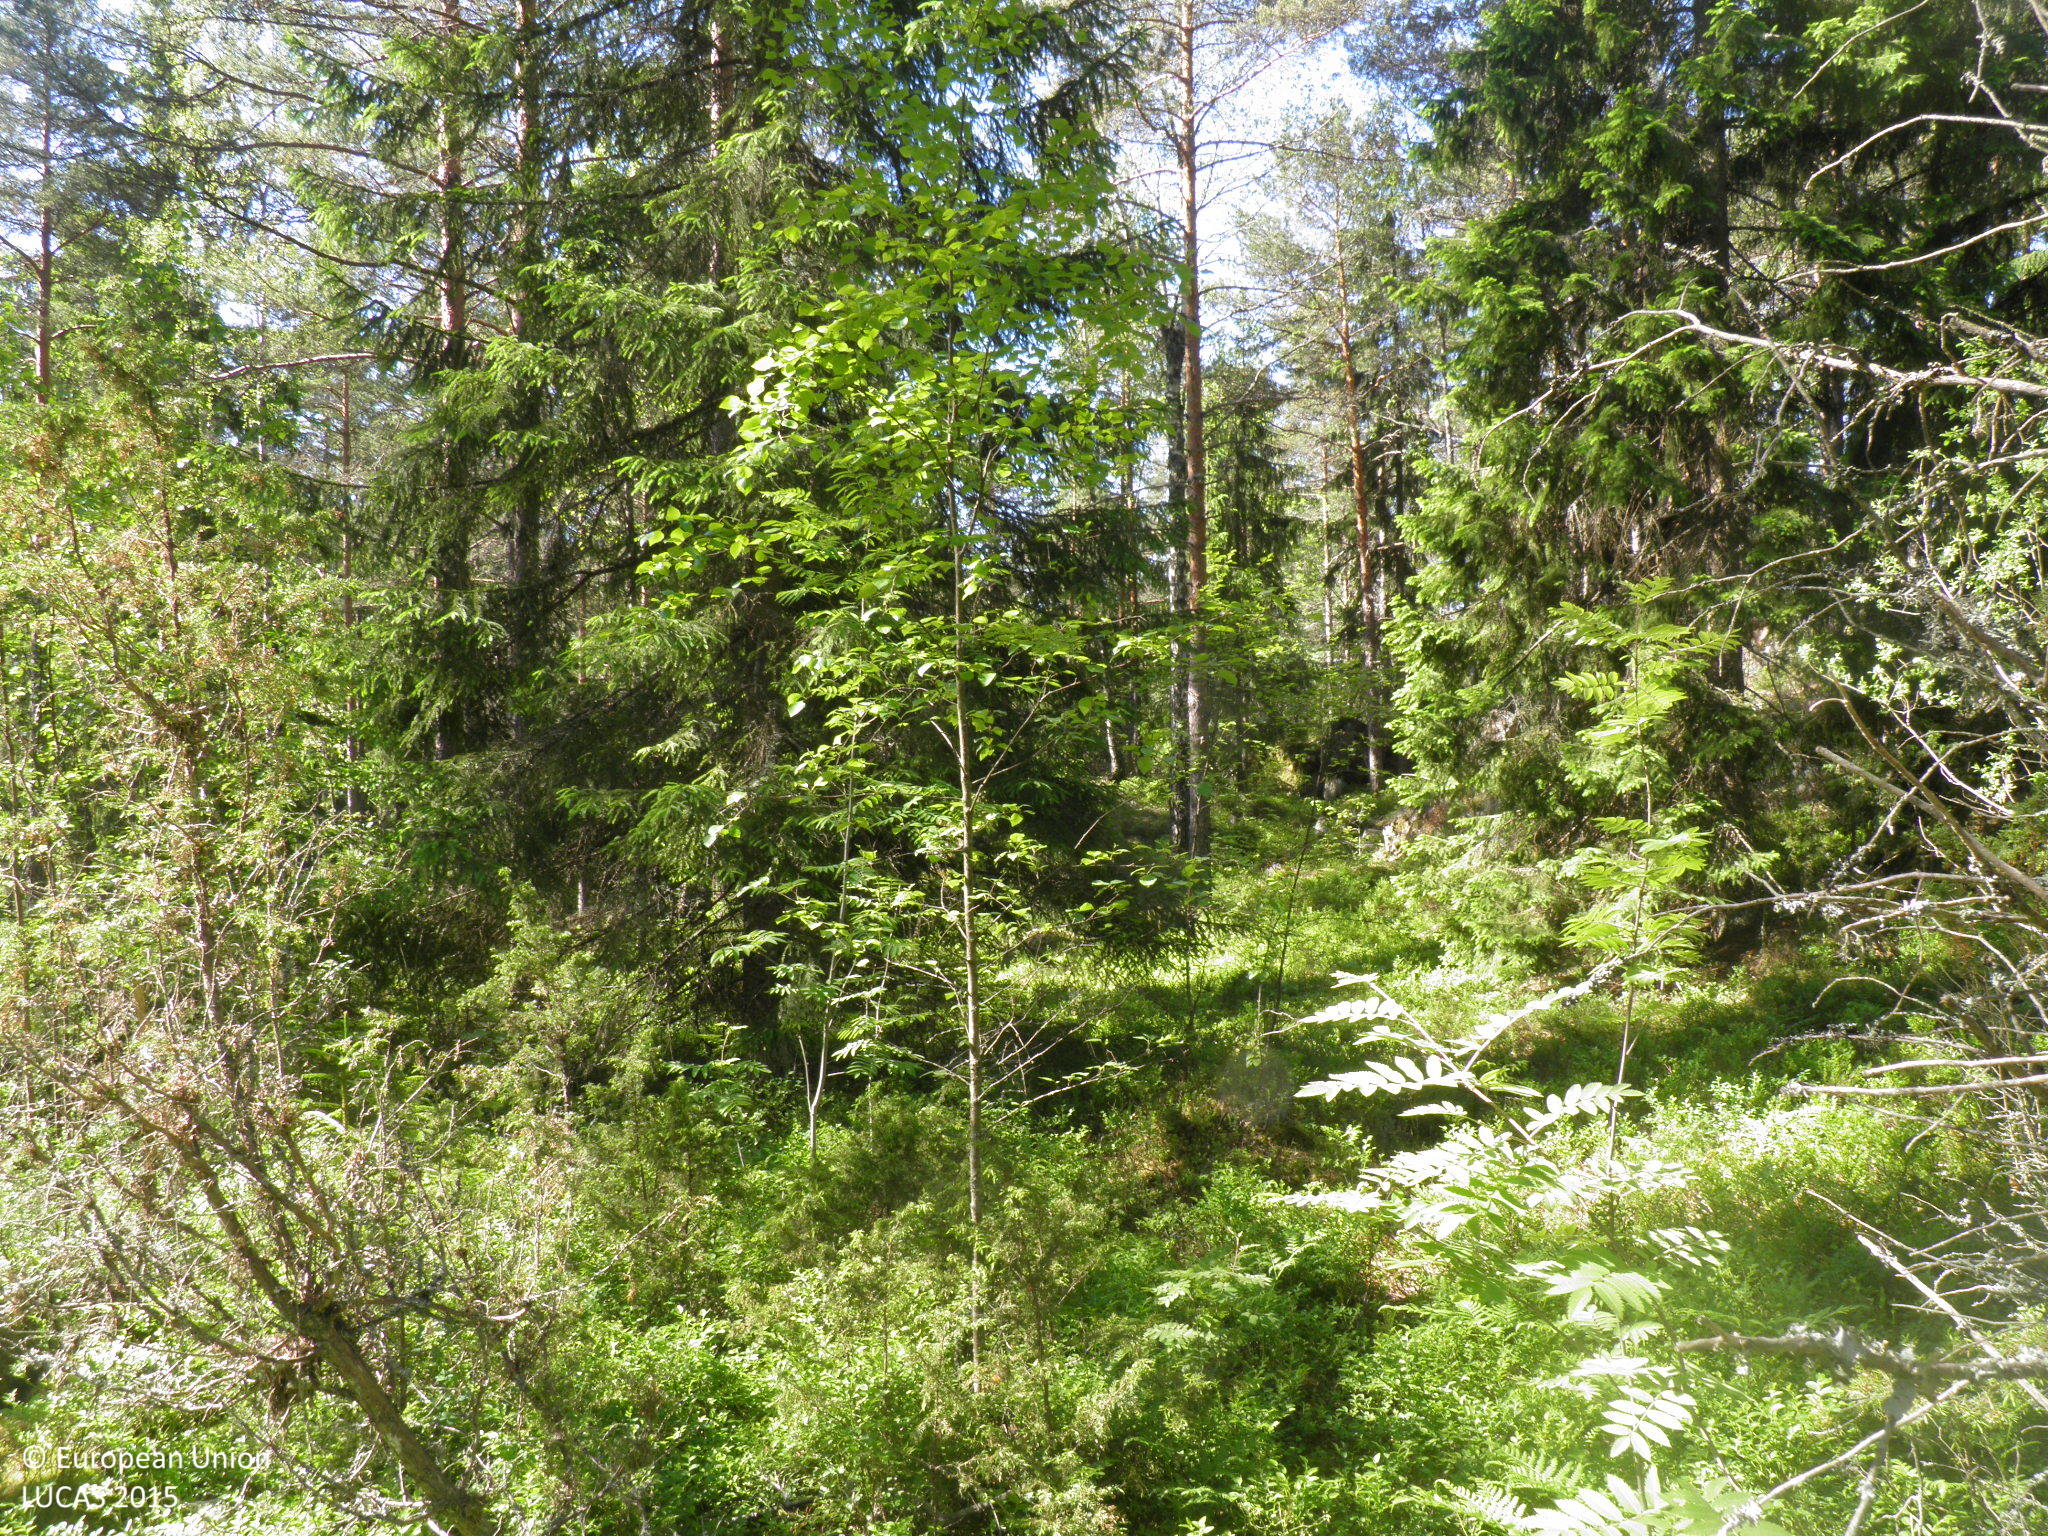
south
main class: Woodland
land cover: Other coniferous woodland
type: hemiboreal forest and nemoral coniferous forest and mixed broadleaved-coniferous forest
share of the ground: 50 - 75 %
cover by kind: coniferous forest trees 60 %, shrubs 15 %, herbaceous plants 15 %, broadleaved forest trees 10 %
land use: Forestry
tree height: > 5 m
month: June
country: FI
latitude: 60.4148
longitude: 22.6197
